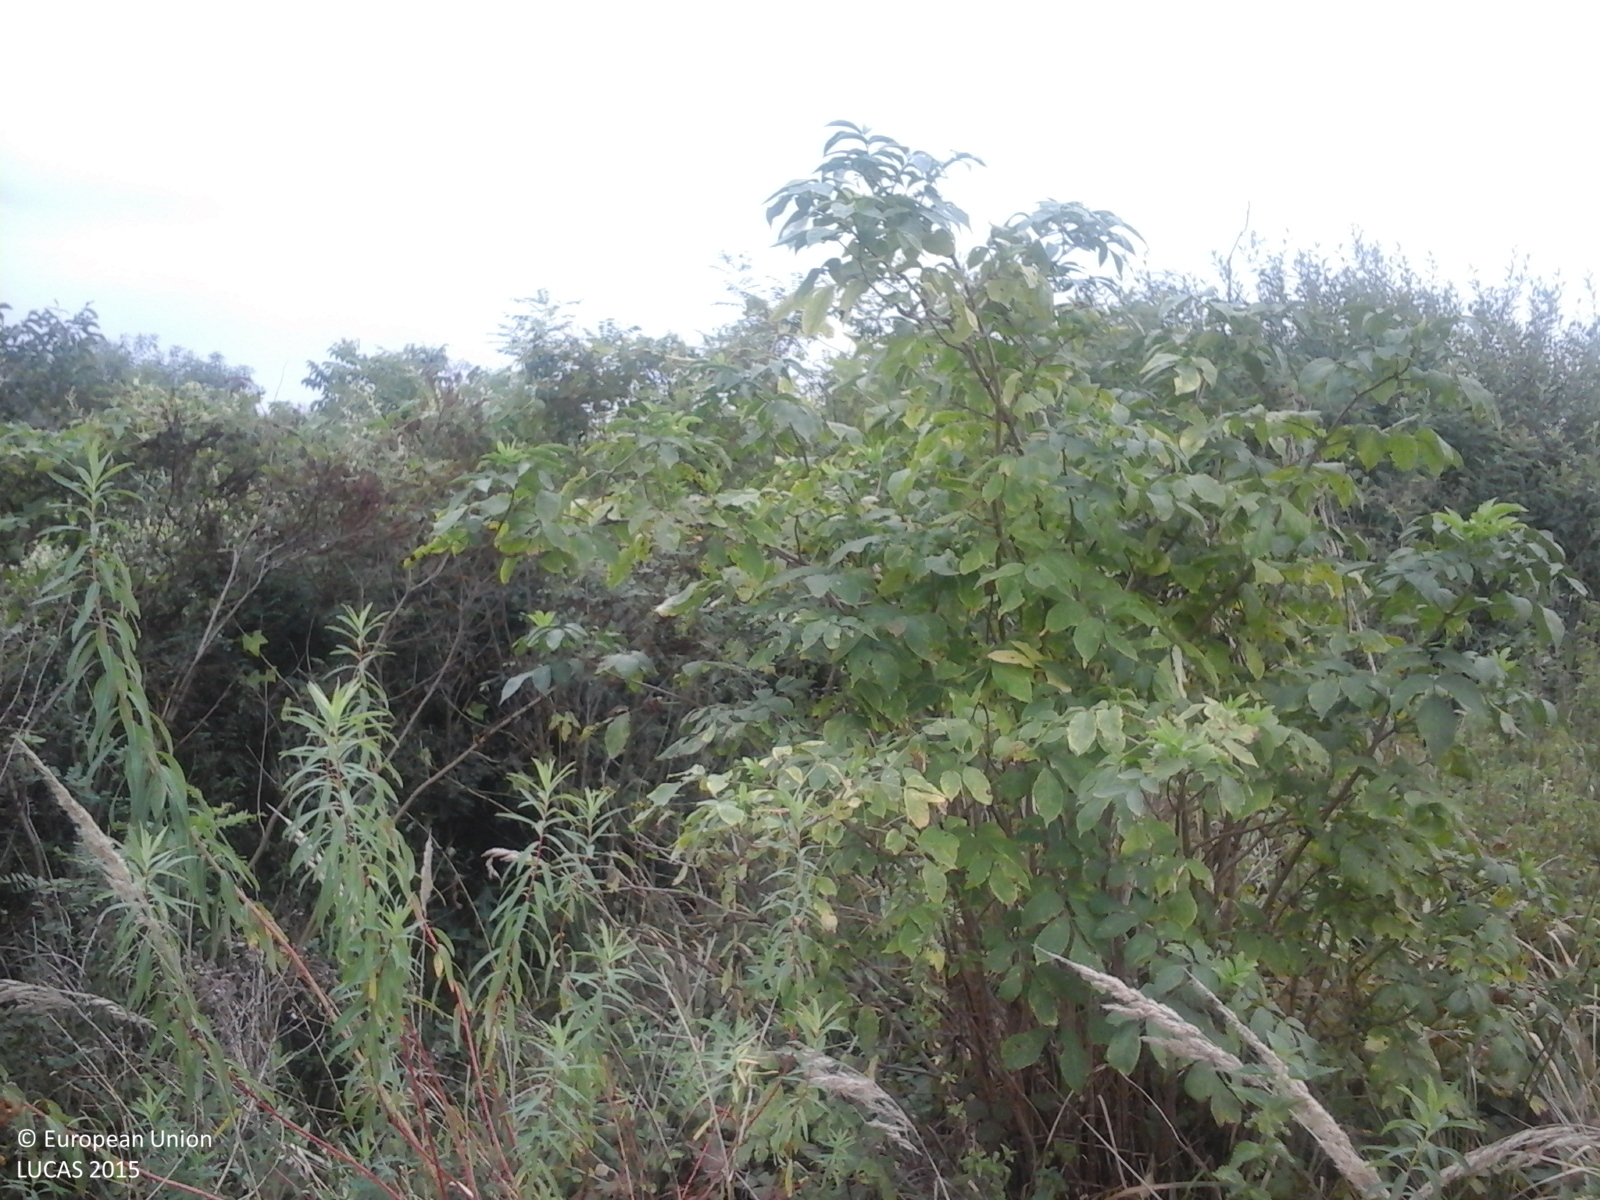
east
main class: Shrubland
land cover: Shrubland with sparse tree cover
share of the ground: > 75 %
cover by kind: shrubs 75 %, herbaceous plants 20 %, broadleaved forest trees 5 %
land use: Semi-natural and natural areas not in use
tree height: < 5 m
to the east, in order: Shrubland with sparse tree cover; Common wheat; Shrubland with sparse tree cover; Ditches and canals; Shrubland with sparse tree cover; Maize; Shrubland without tree cover; Maize
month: September
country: RO
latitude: 47.3233
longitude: 22.0499
